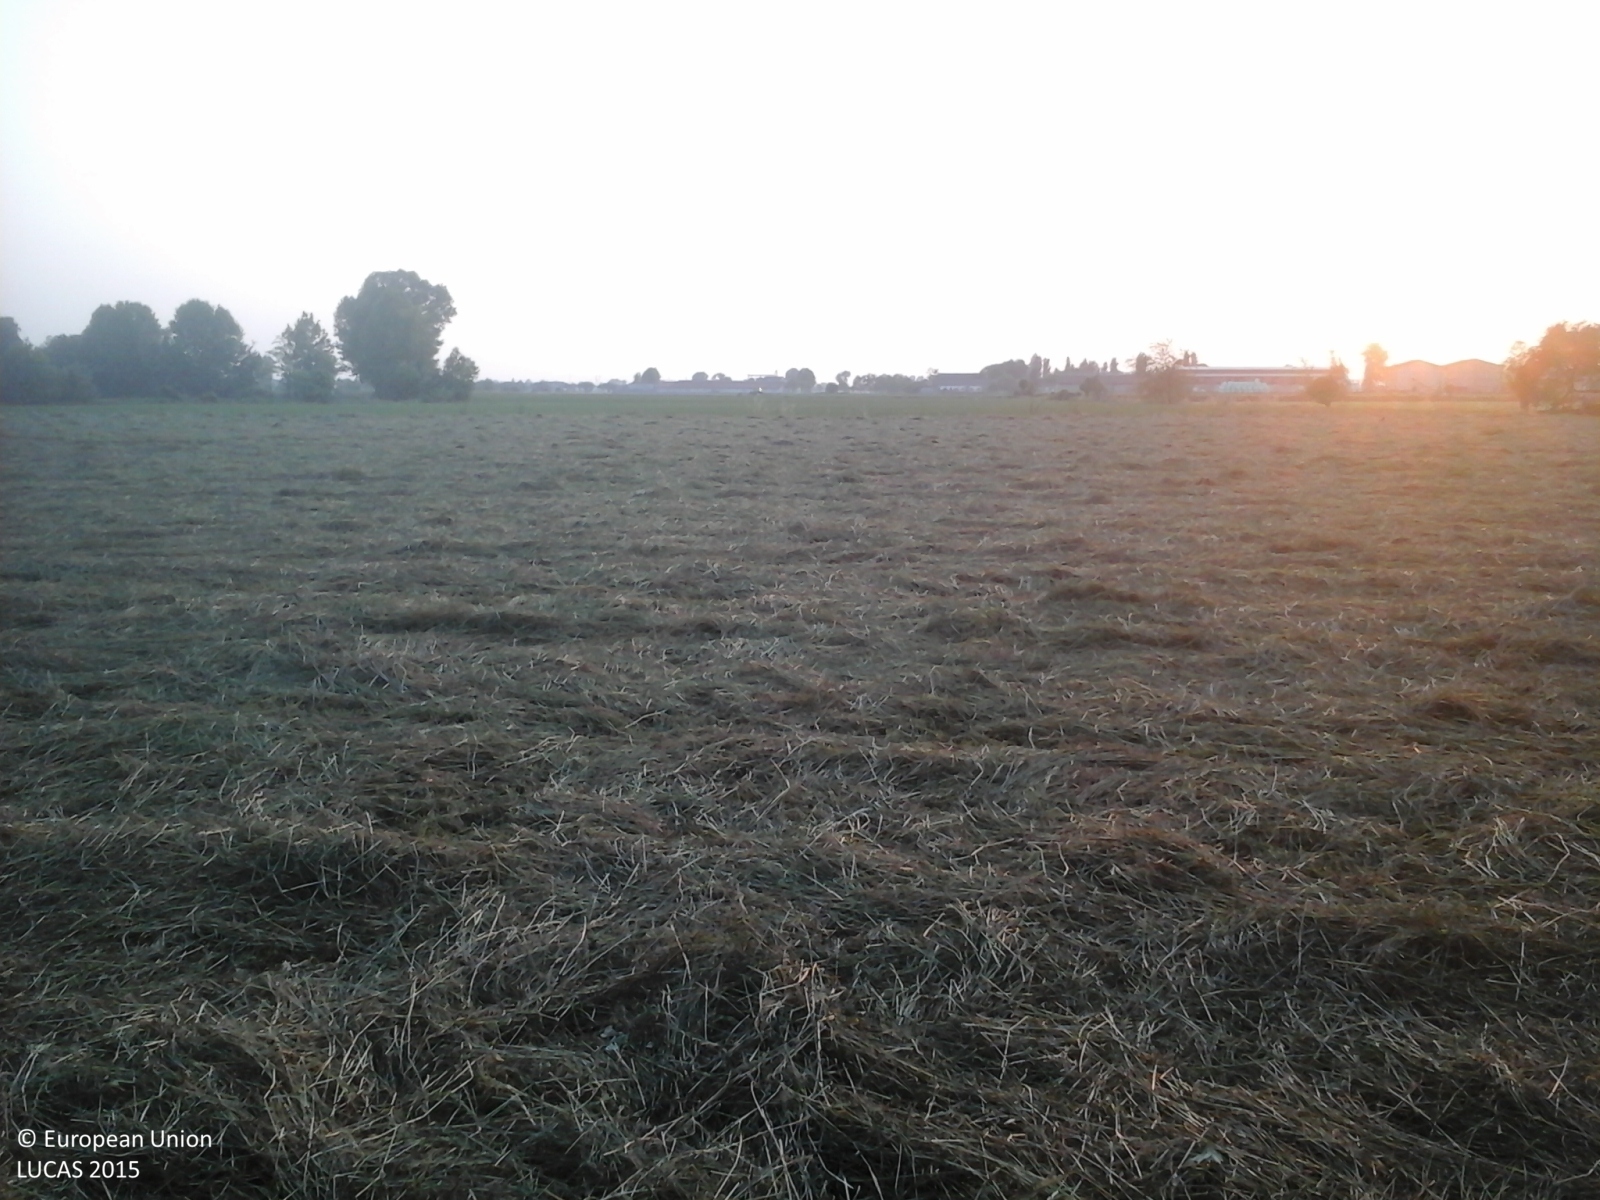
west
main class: Grassland
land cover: Grassland without tree/shrub cover
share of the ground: > 75 %
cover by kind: herbaceous plants 100 %
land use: Agriculture (excluding fallow land and kitchen gardens)
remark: Harvested field
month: May
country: IT
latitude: 45.3595
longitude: 10.3950
